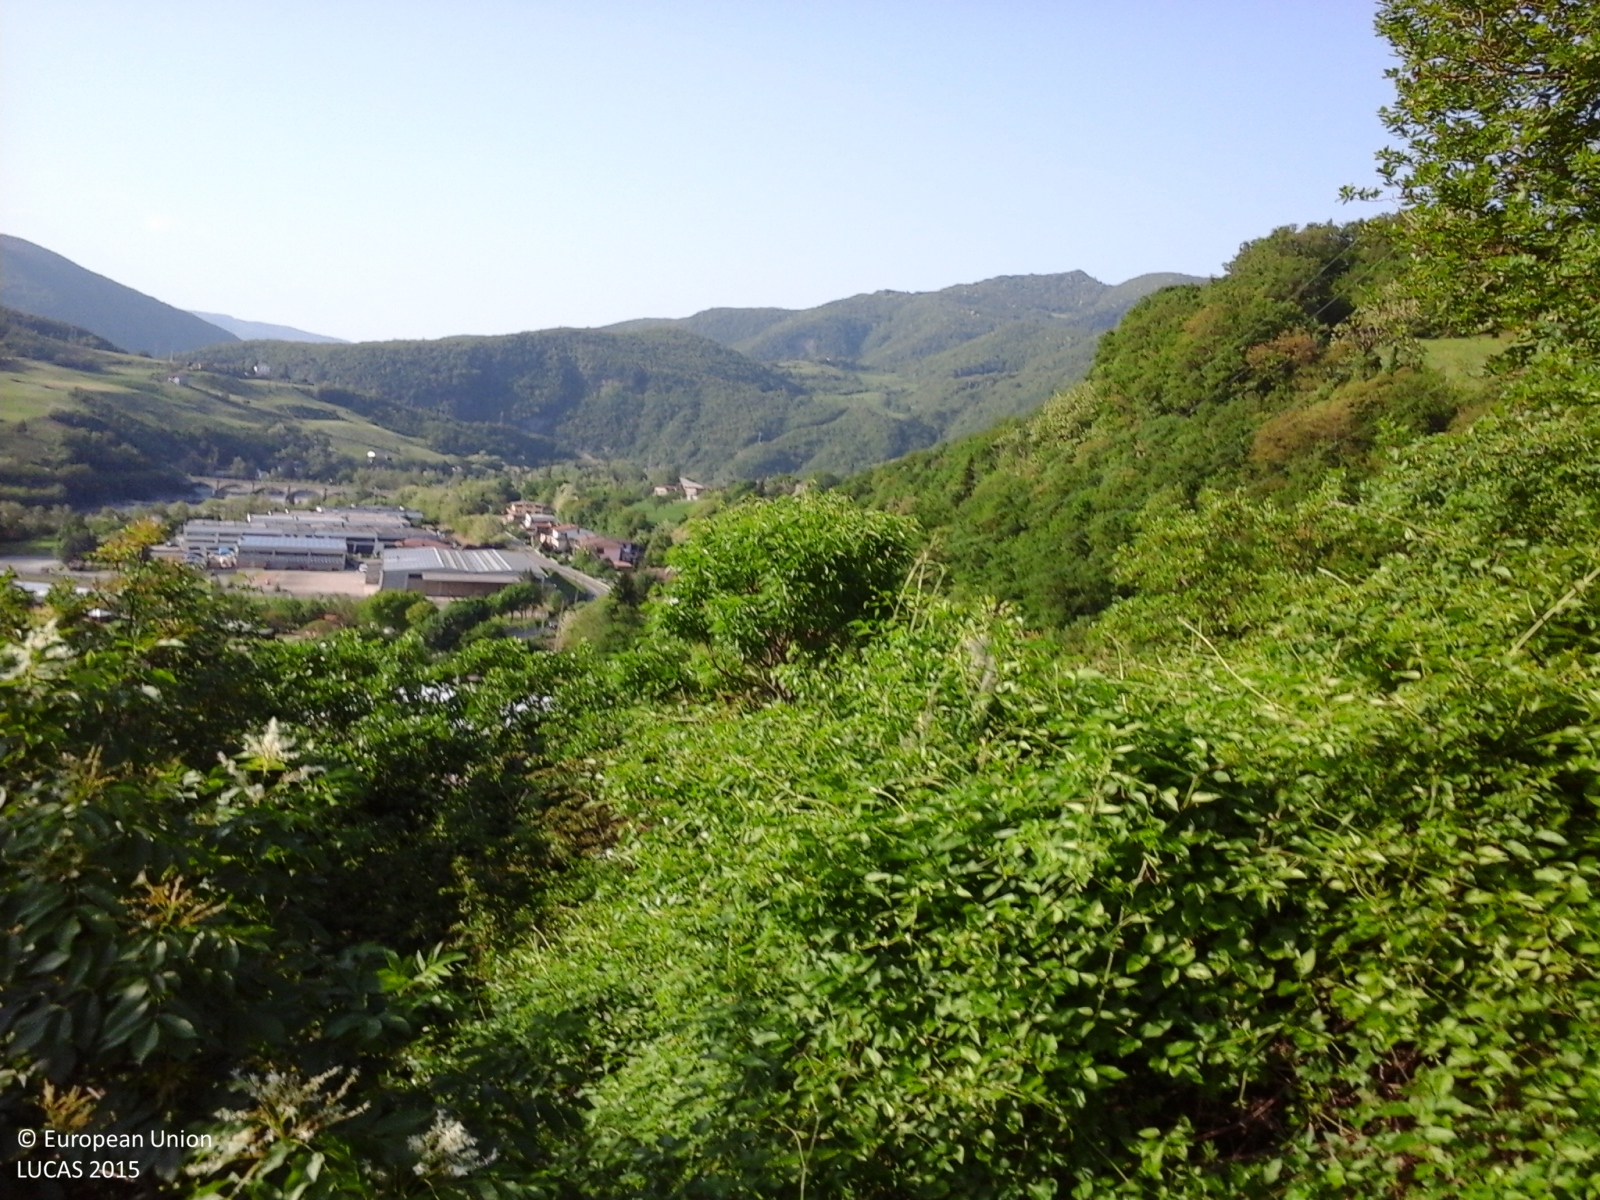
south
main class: Woodland
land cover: Broadleaved woodland
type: mesophytic deciduous forest
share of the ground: > 75 %
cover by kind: broadleaved forest trees 100 %
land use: Forestry
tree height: > 5 m
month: May
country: IT
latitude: 44.7635
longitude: 9.3822
